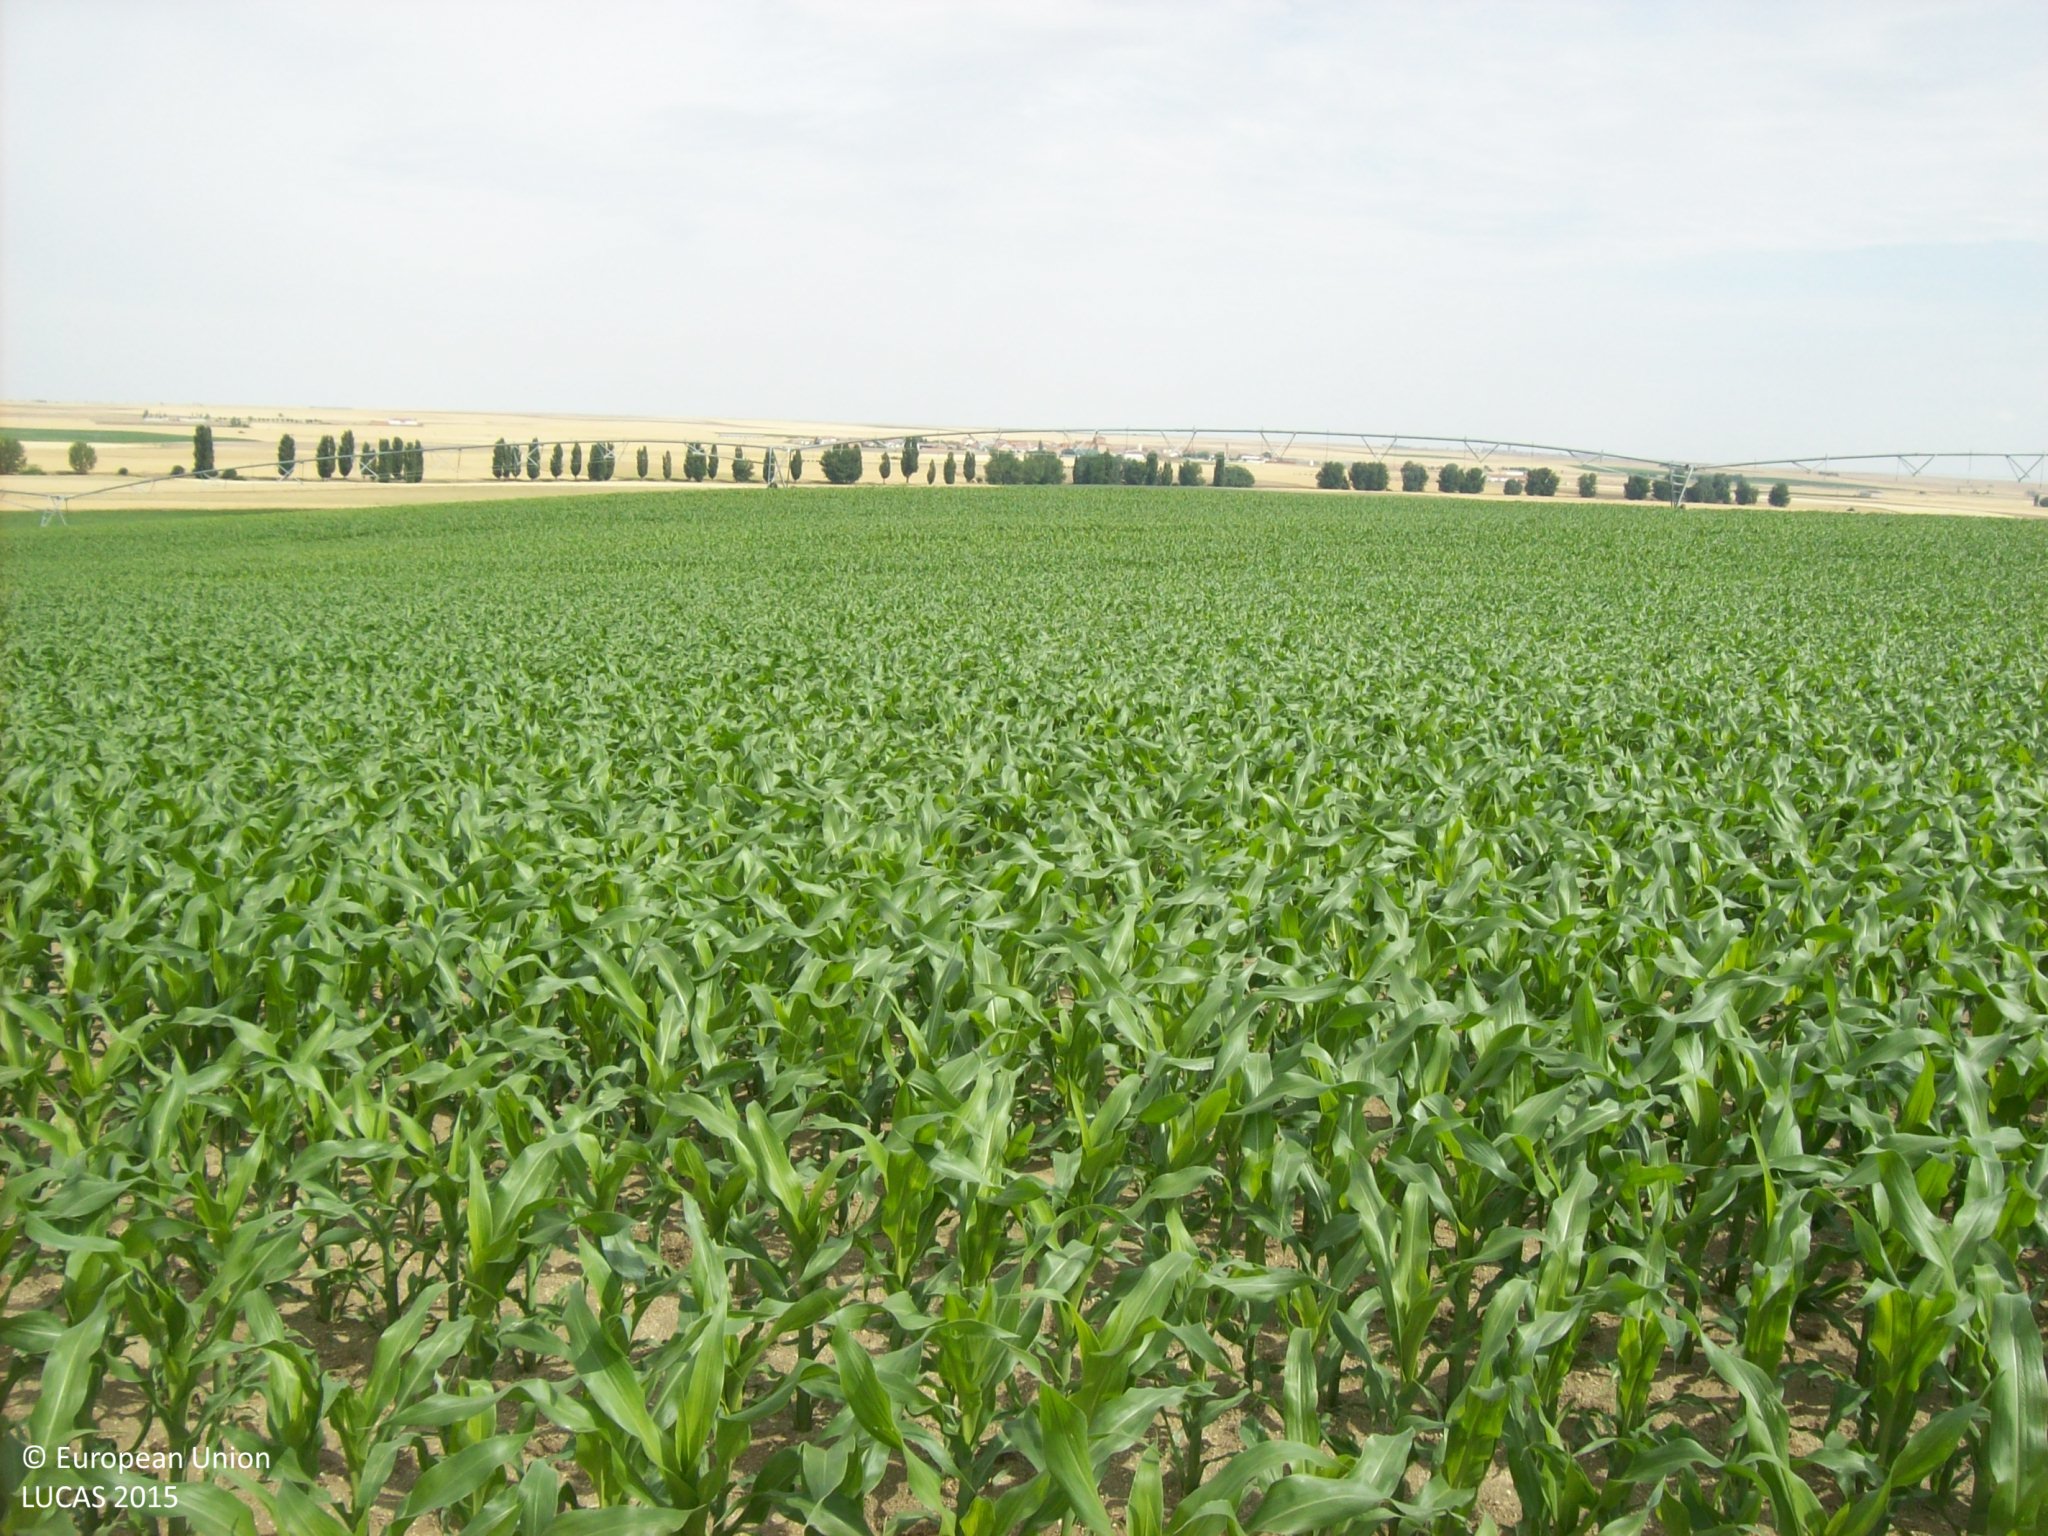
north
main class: Cropland
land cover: Maize
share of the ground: > 75 %
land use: Agriculture (excluding fallow land and kitchen gardens)
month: June
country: ES
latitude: 40.9964
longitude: -5.0085
